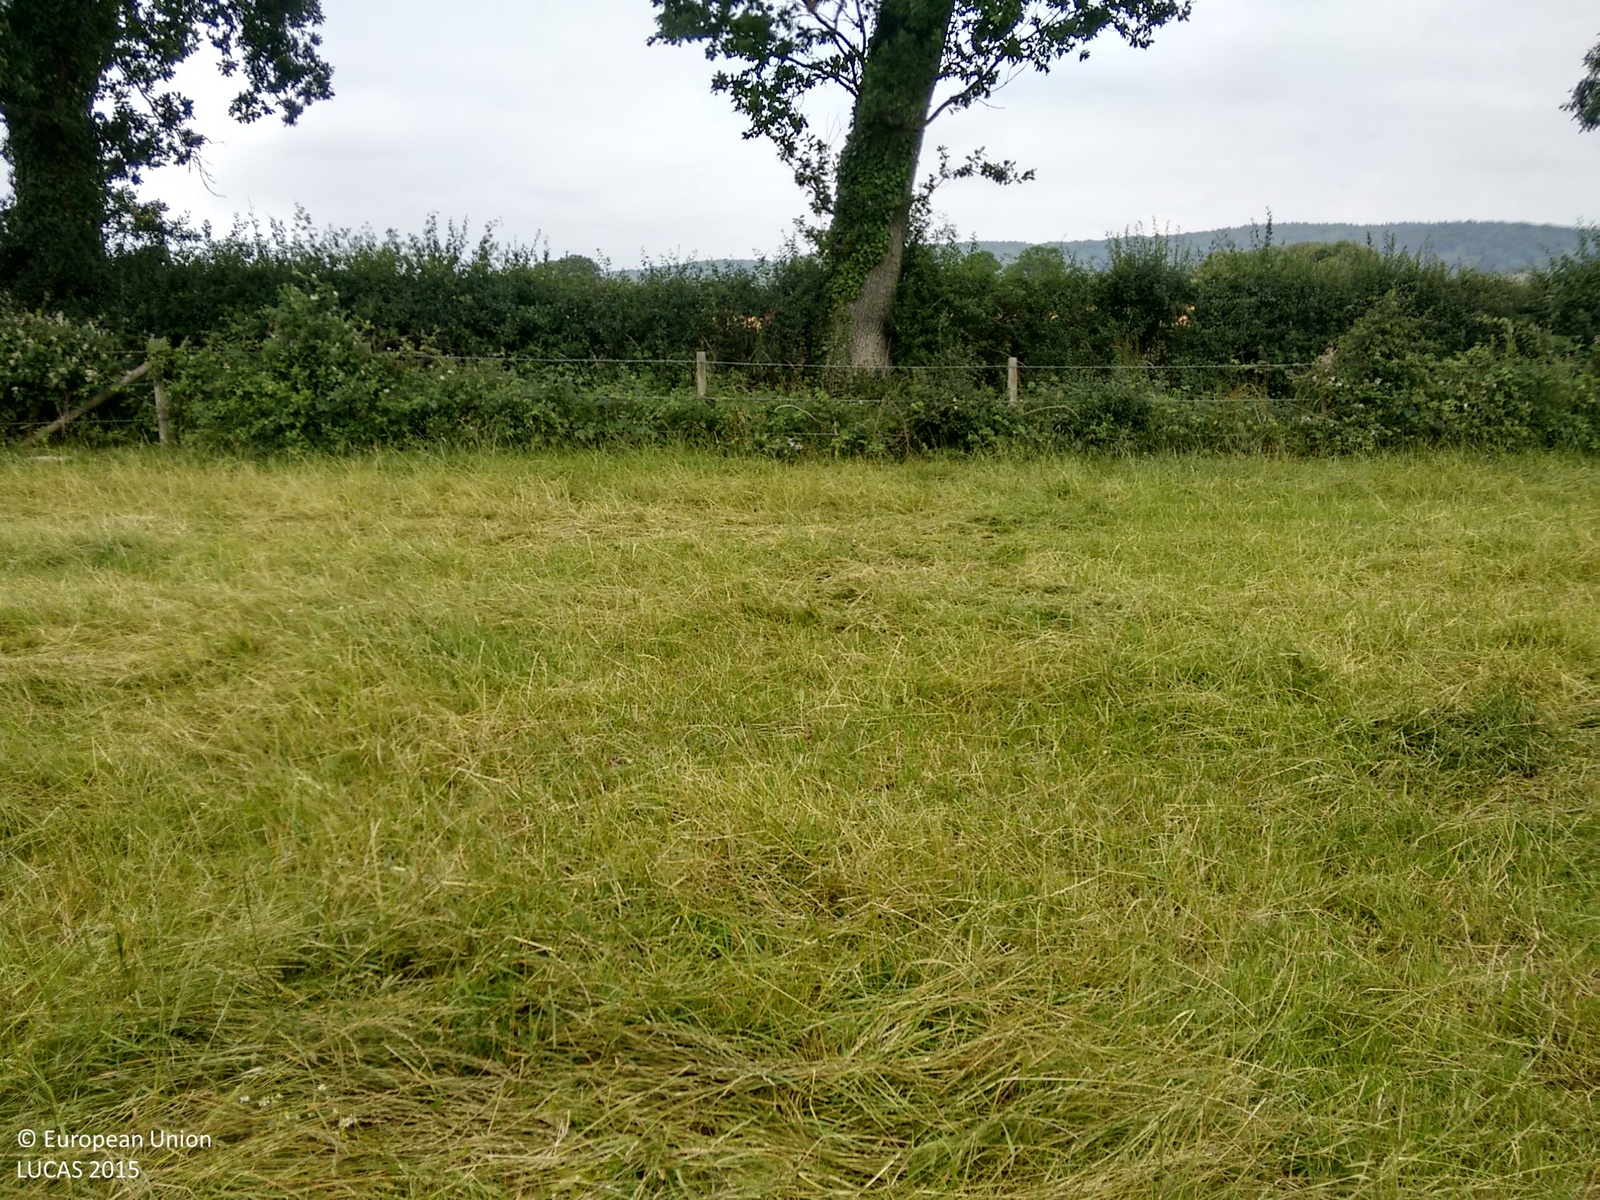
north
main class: Grassland
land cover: Grassland without tree/shrub cover
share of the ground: > 75 %
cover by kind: herbaceous plants 100 %
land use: Agriculture (excluding fallow land and kitchen gardens)
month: July
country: GB
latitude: 51.3553
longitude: -2.7797
